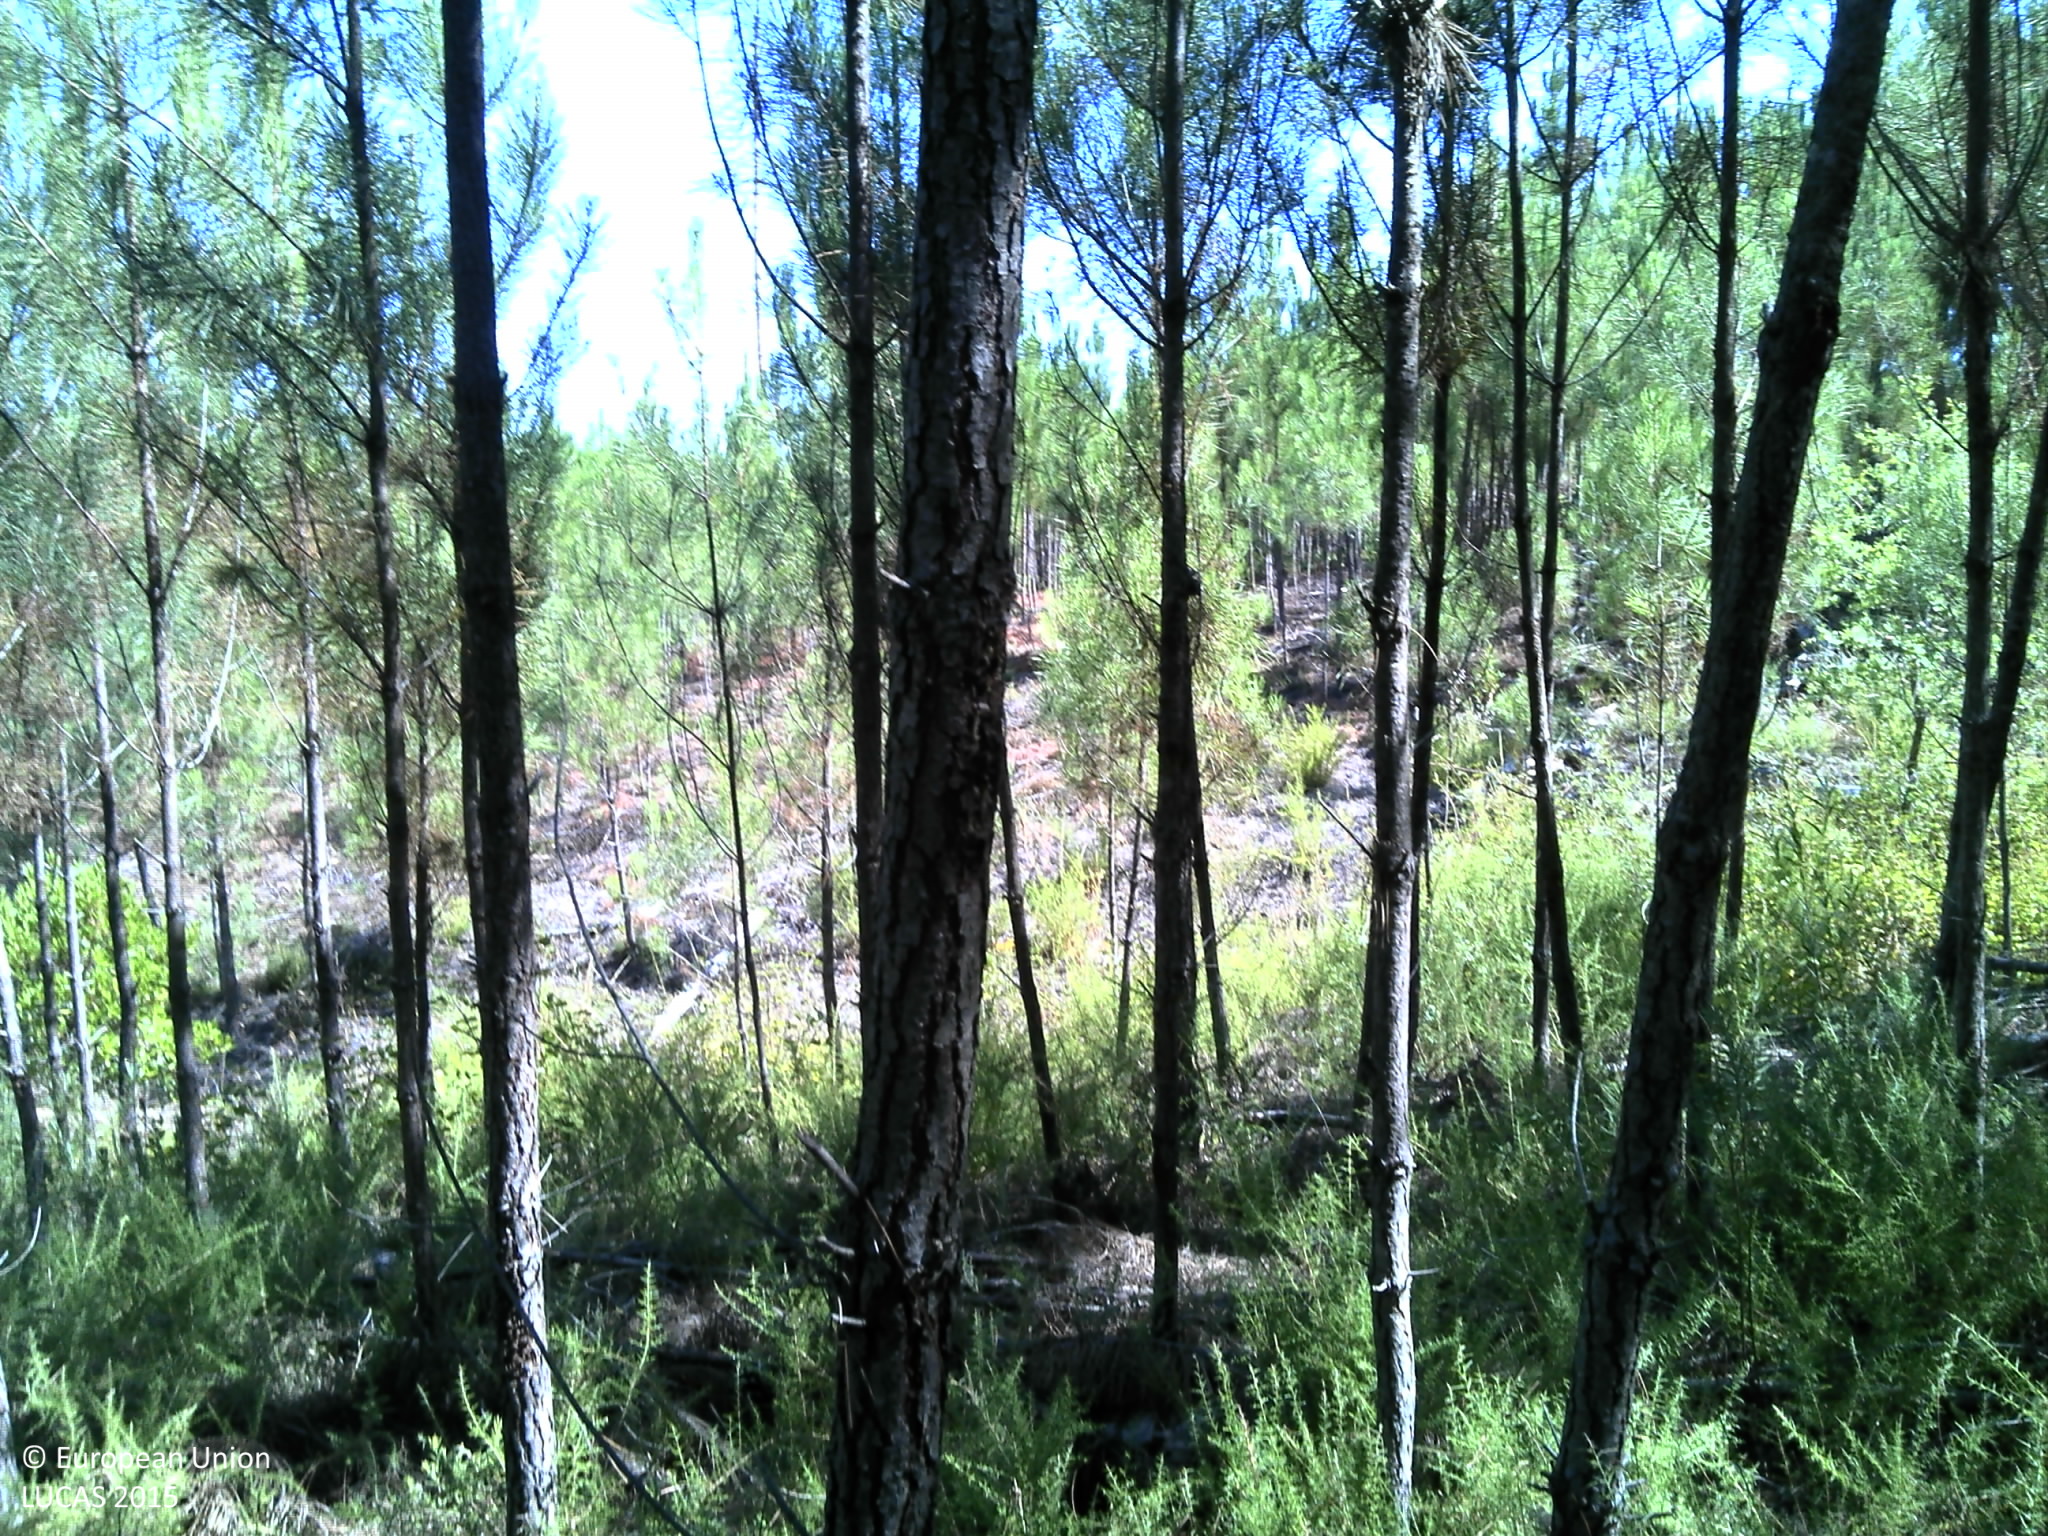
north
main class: Woodland
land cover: Pine dominated coniferous woodland
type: coniferous forest of the mediterranean region
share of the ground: 50 - 75 %
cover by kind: coniferous forest trees 50 %, shrubs 20 %, unconsolidated bare surface 10 %
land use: Forestry
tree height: > 5 m
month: July
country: PT
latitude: 39.7252
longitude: -8.1386
